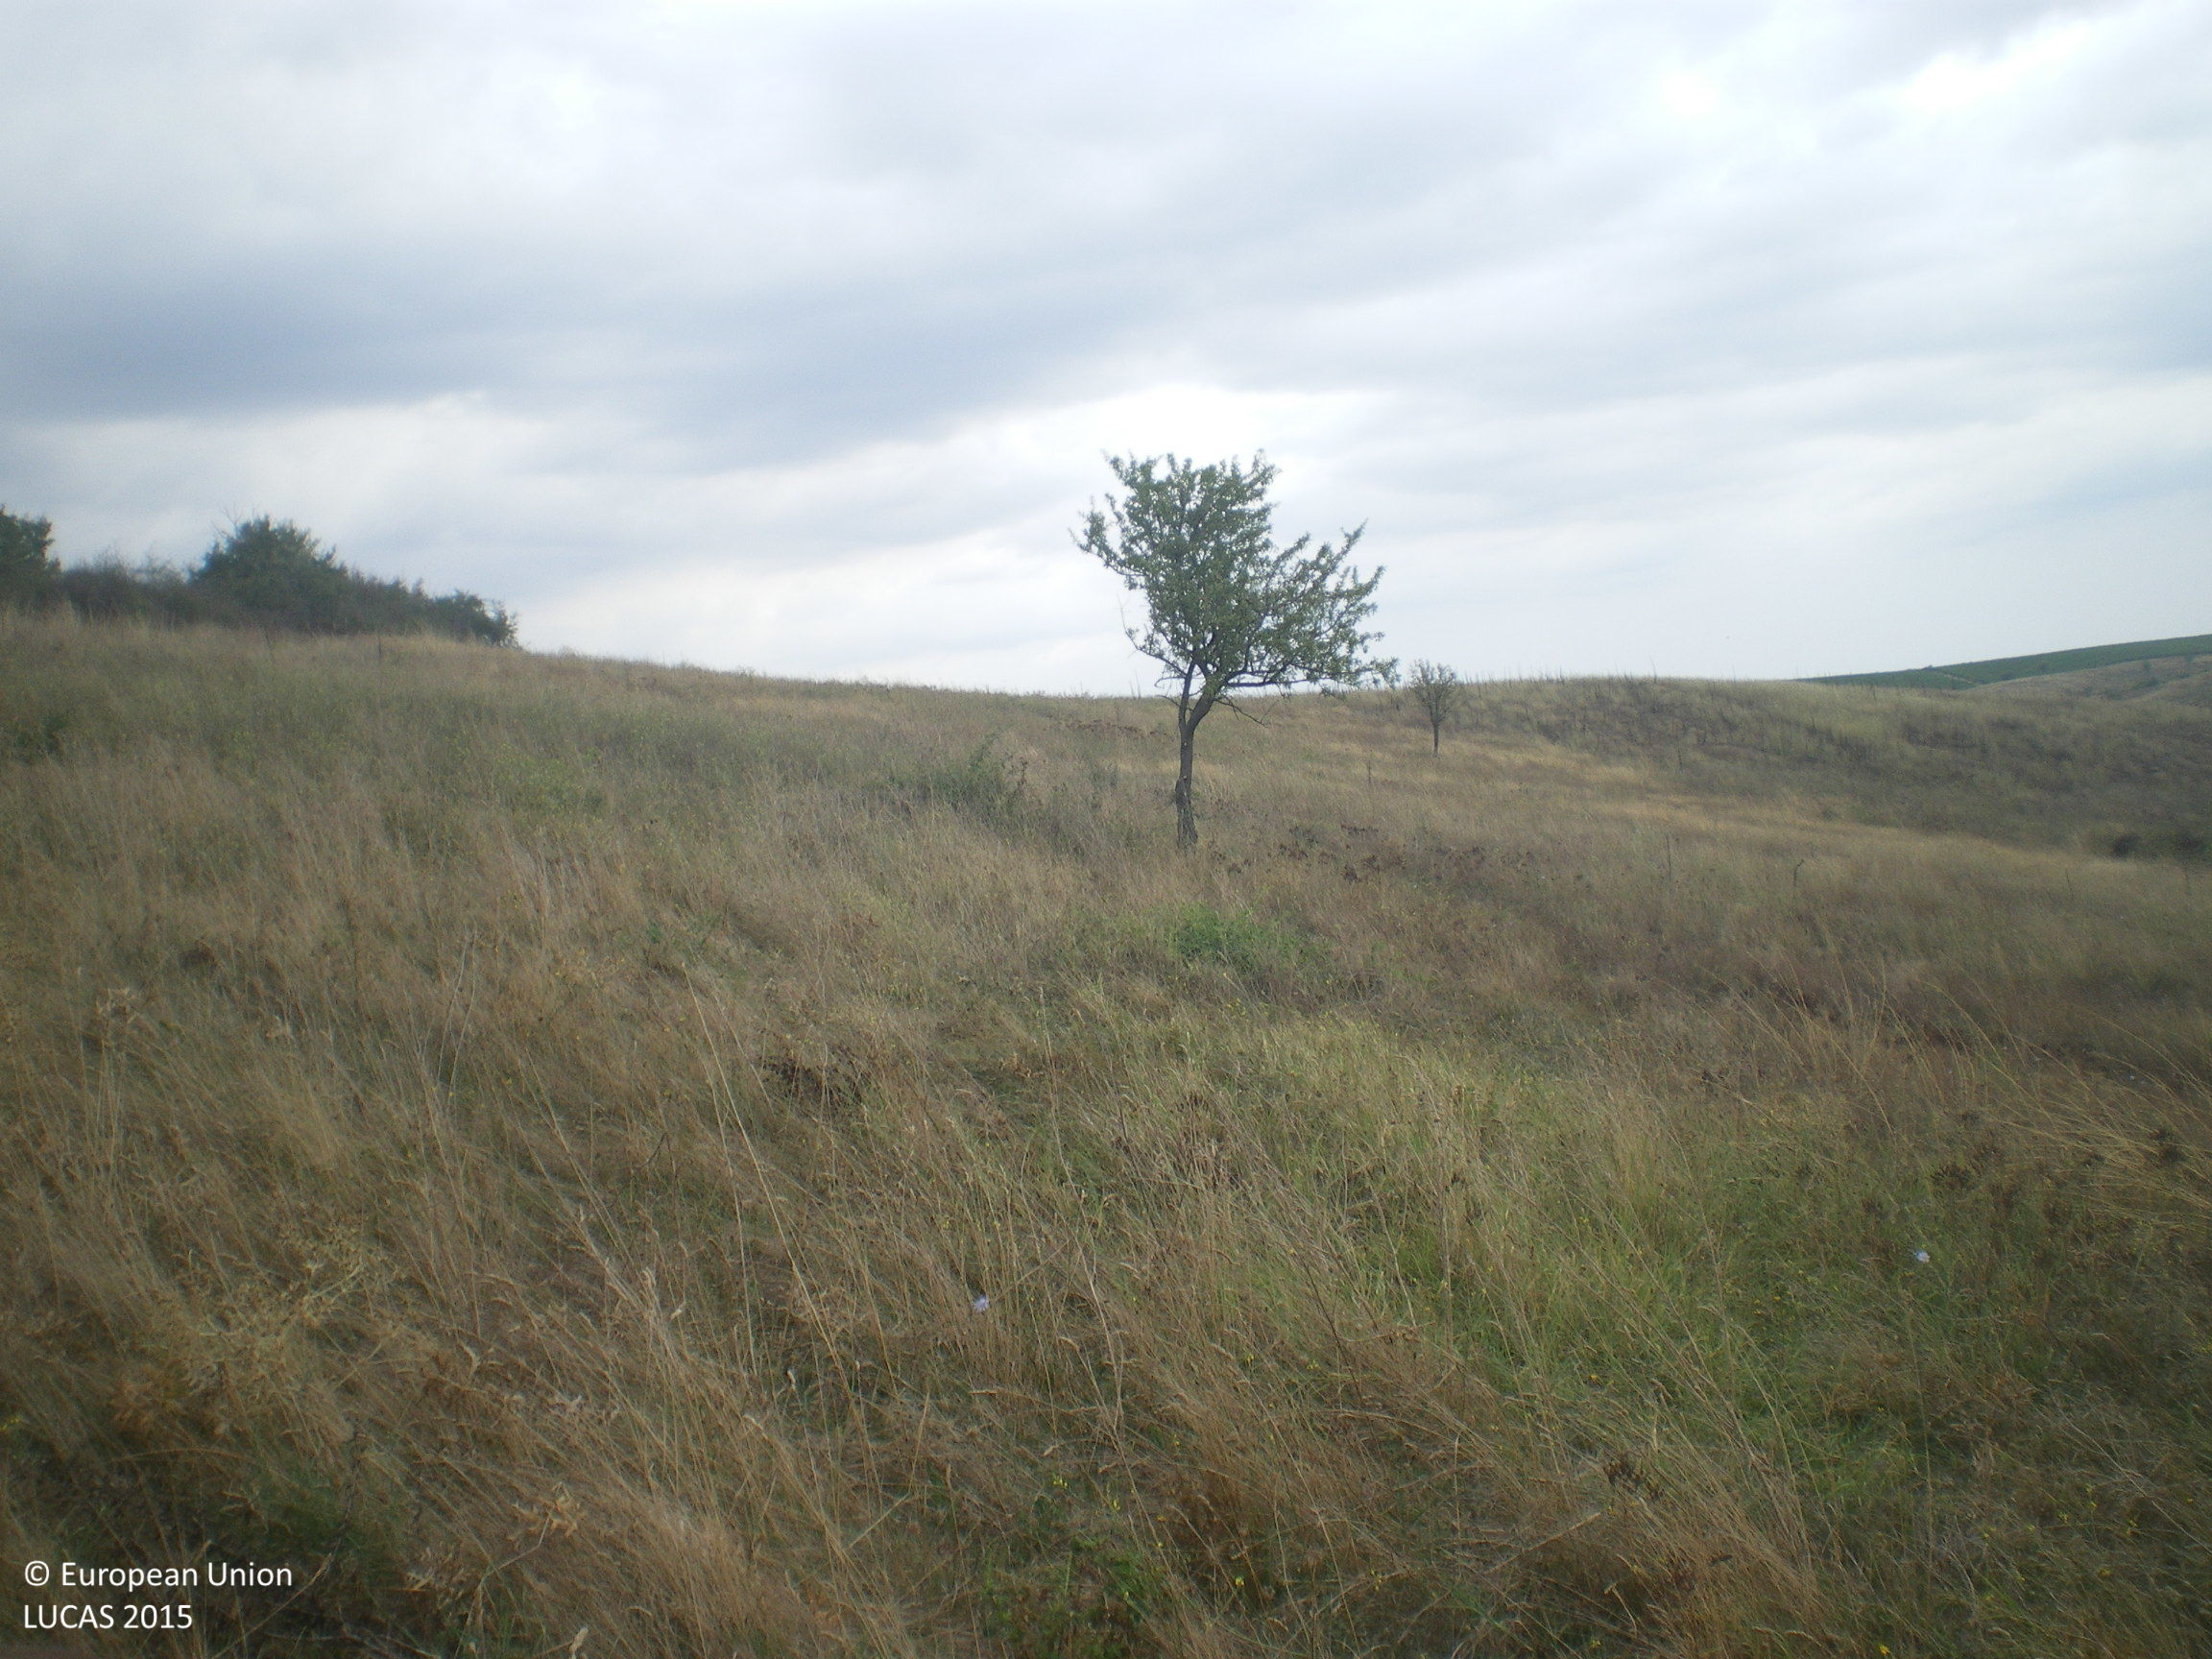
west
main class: Grassland
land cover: Grassland with sparse tree/shrub cover
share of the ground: > 75 %
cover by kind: herbaceous plants 90 %, broadleaved forest trees 5 %, shrubs 5 %
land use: Semi-natural and natural areas not in use
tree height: > 5 m
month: September
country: BG
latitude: 42.0190
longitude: 25.9788
